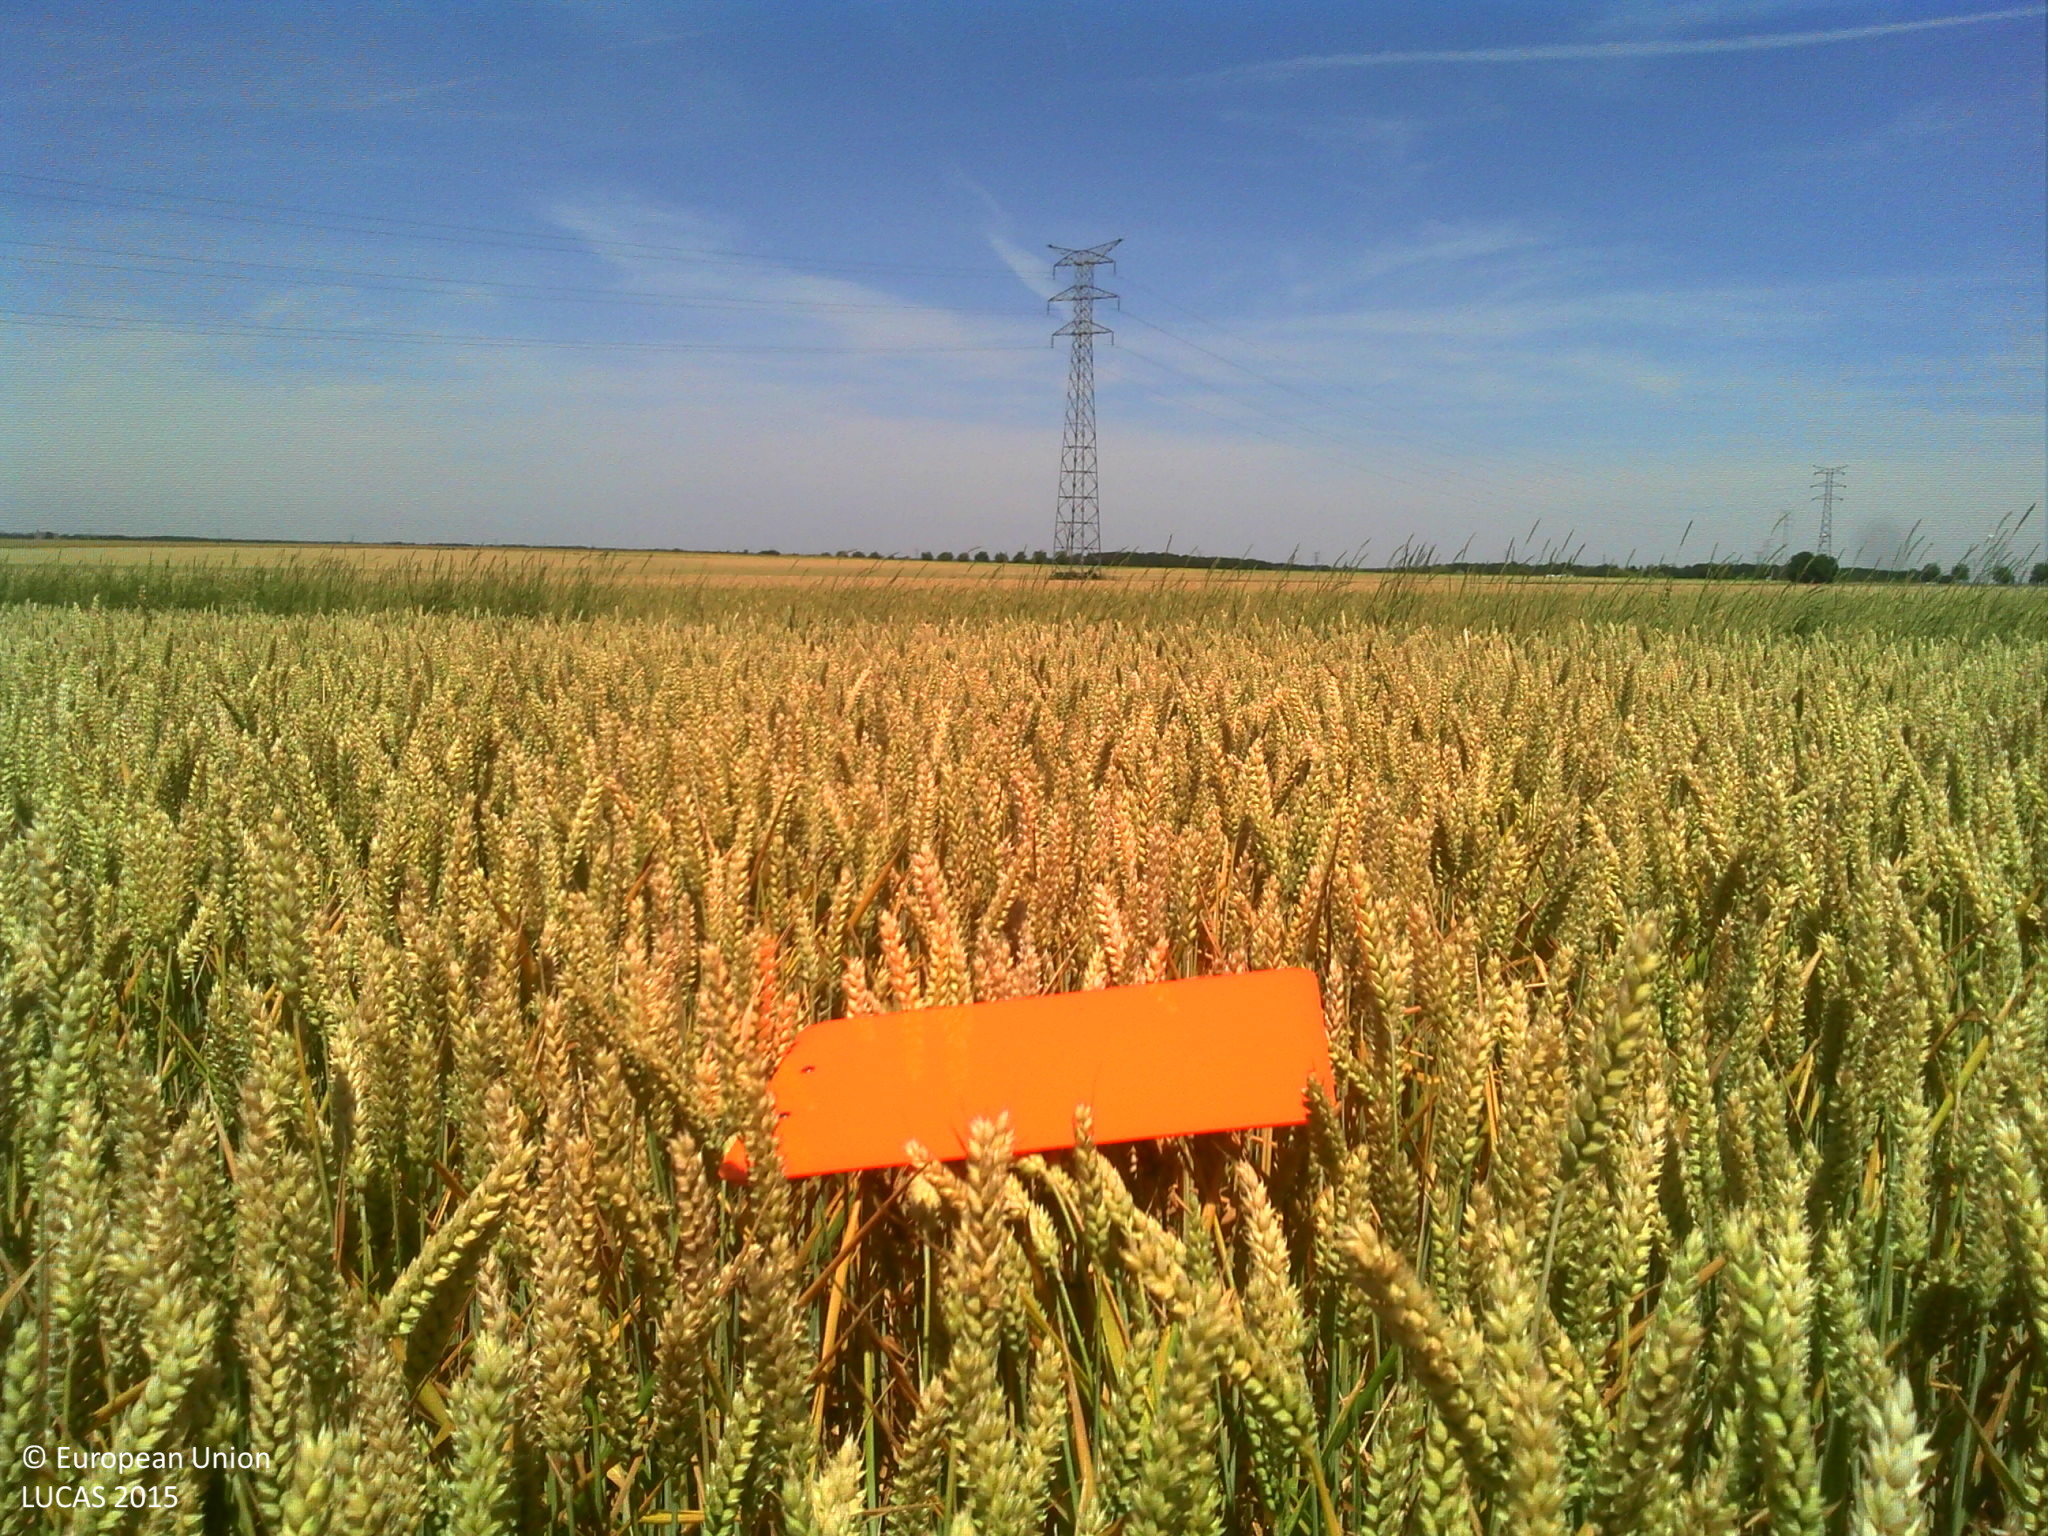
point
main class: Cropland
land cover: Common wheat
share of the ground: > 75 %
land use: Agriculture (excluding fallow land and kitchen gardens)
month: June
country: FR
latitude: 48.6462
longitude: 1.3905
